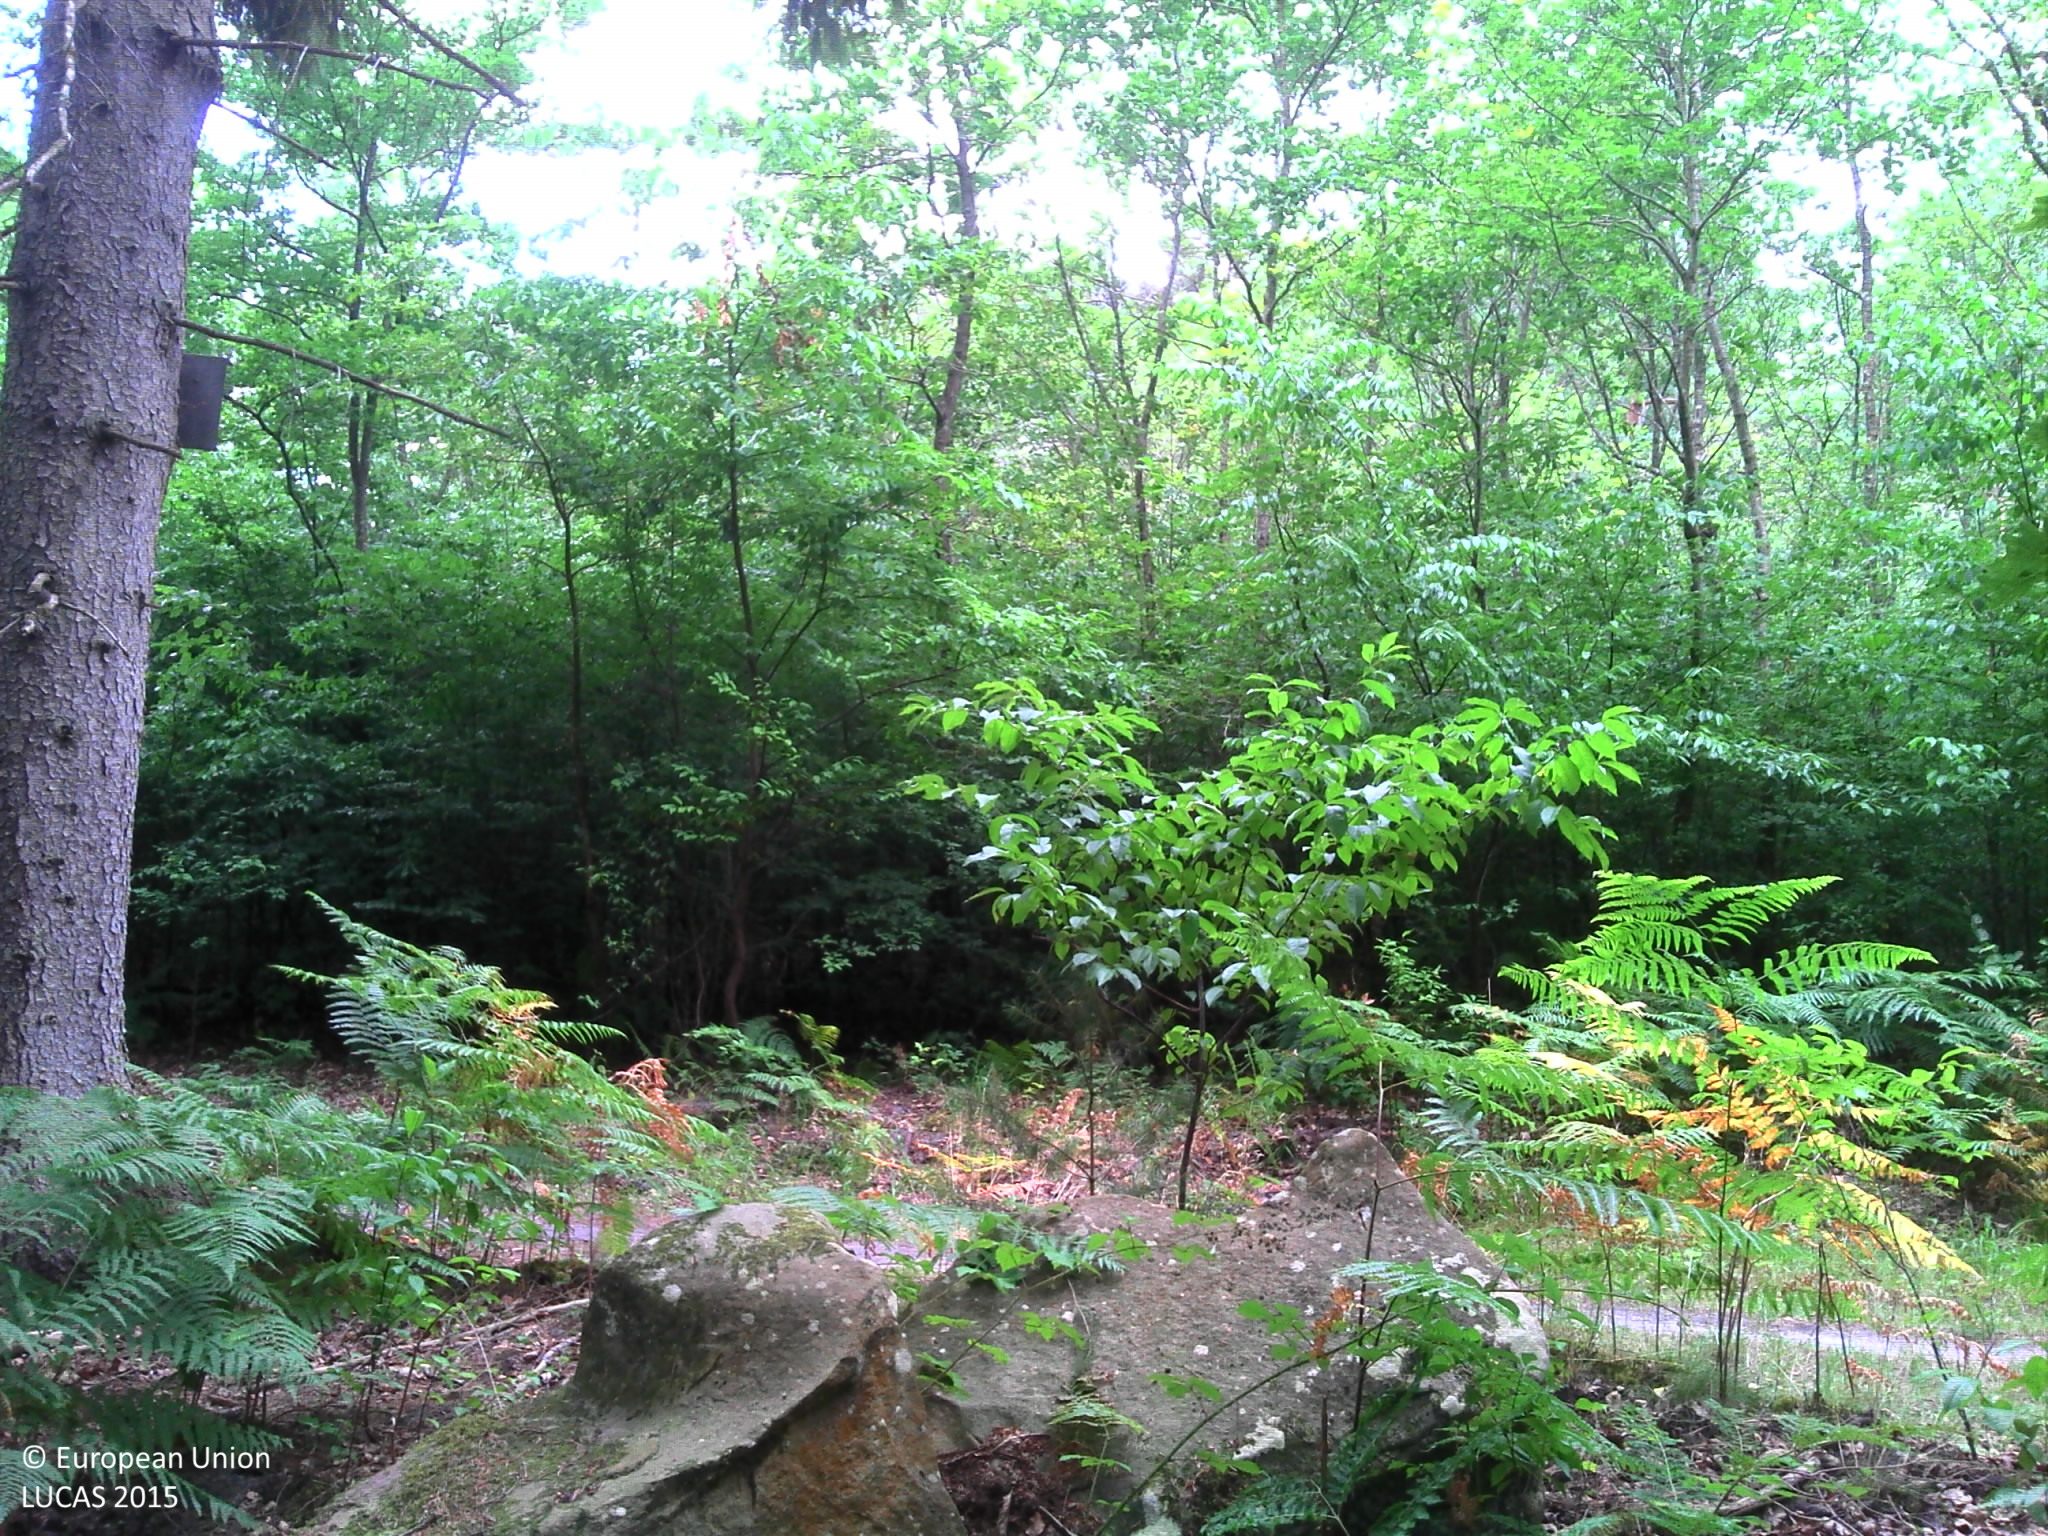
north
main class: Woodland
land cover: Pine dominated mixed woodland
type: hemiboreal forest and nemoral coniferous forest and mixed broadleaved-coniferous forest
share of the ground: > 75 %
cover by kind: coniferous forest trees 40 %, broadleaved forest trees 20 %, herbaceous plants 15 %, lichens and mosses 10 %, unconsolidated bare surface 10 %
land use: Forestry
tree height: > 5 m
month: July
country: FR
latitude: 48.4352
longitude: 2.7324
